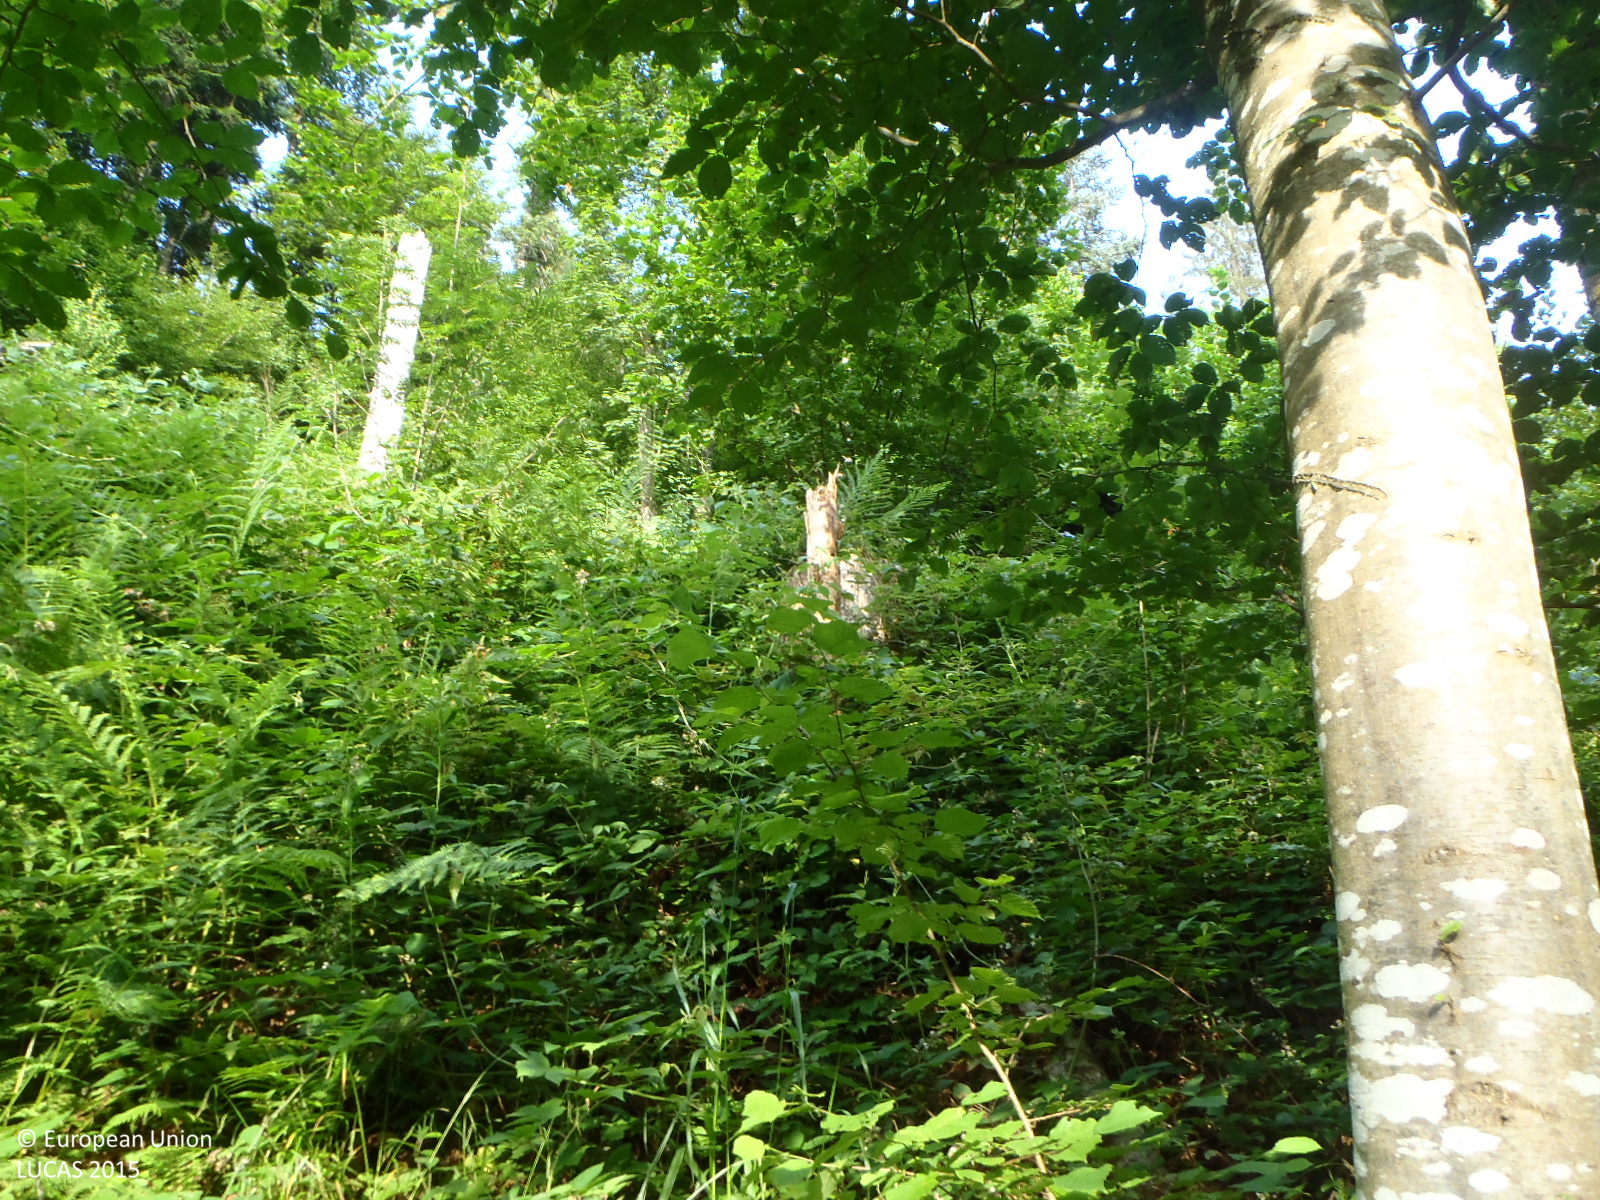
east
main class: Woodland
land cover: Other mixed woodland
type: alpine coniferous forest
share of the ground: > 75 %
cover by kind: coniferous forest trees 35 %, broadleaved forest trees 30 %, shrubs 20 %, herbaceous plants 15 %
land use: Forestry
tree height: > 5 m
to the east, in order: Other mixed woodland; Tracks; Spruce dominated mixed woodland; Shrubland without tree cover; Spruce dominated mixed woodland; Rivers and streams; Spruce dominated mixed woodland; Grass margins; Paved roads, cycling and walking lanes; Grassland without tree/shrub cover
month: July
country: AT
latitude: 47.5126
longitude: 12.4283
